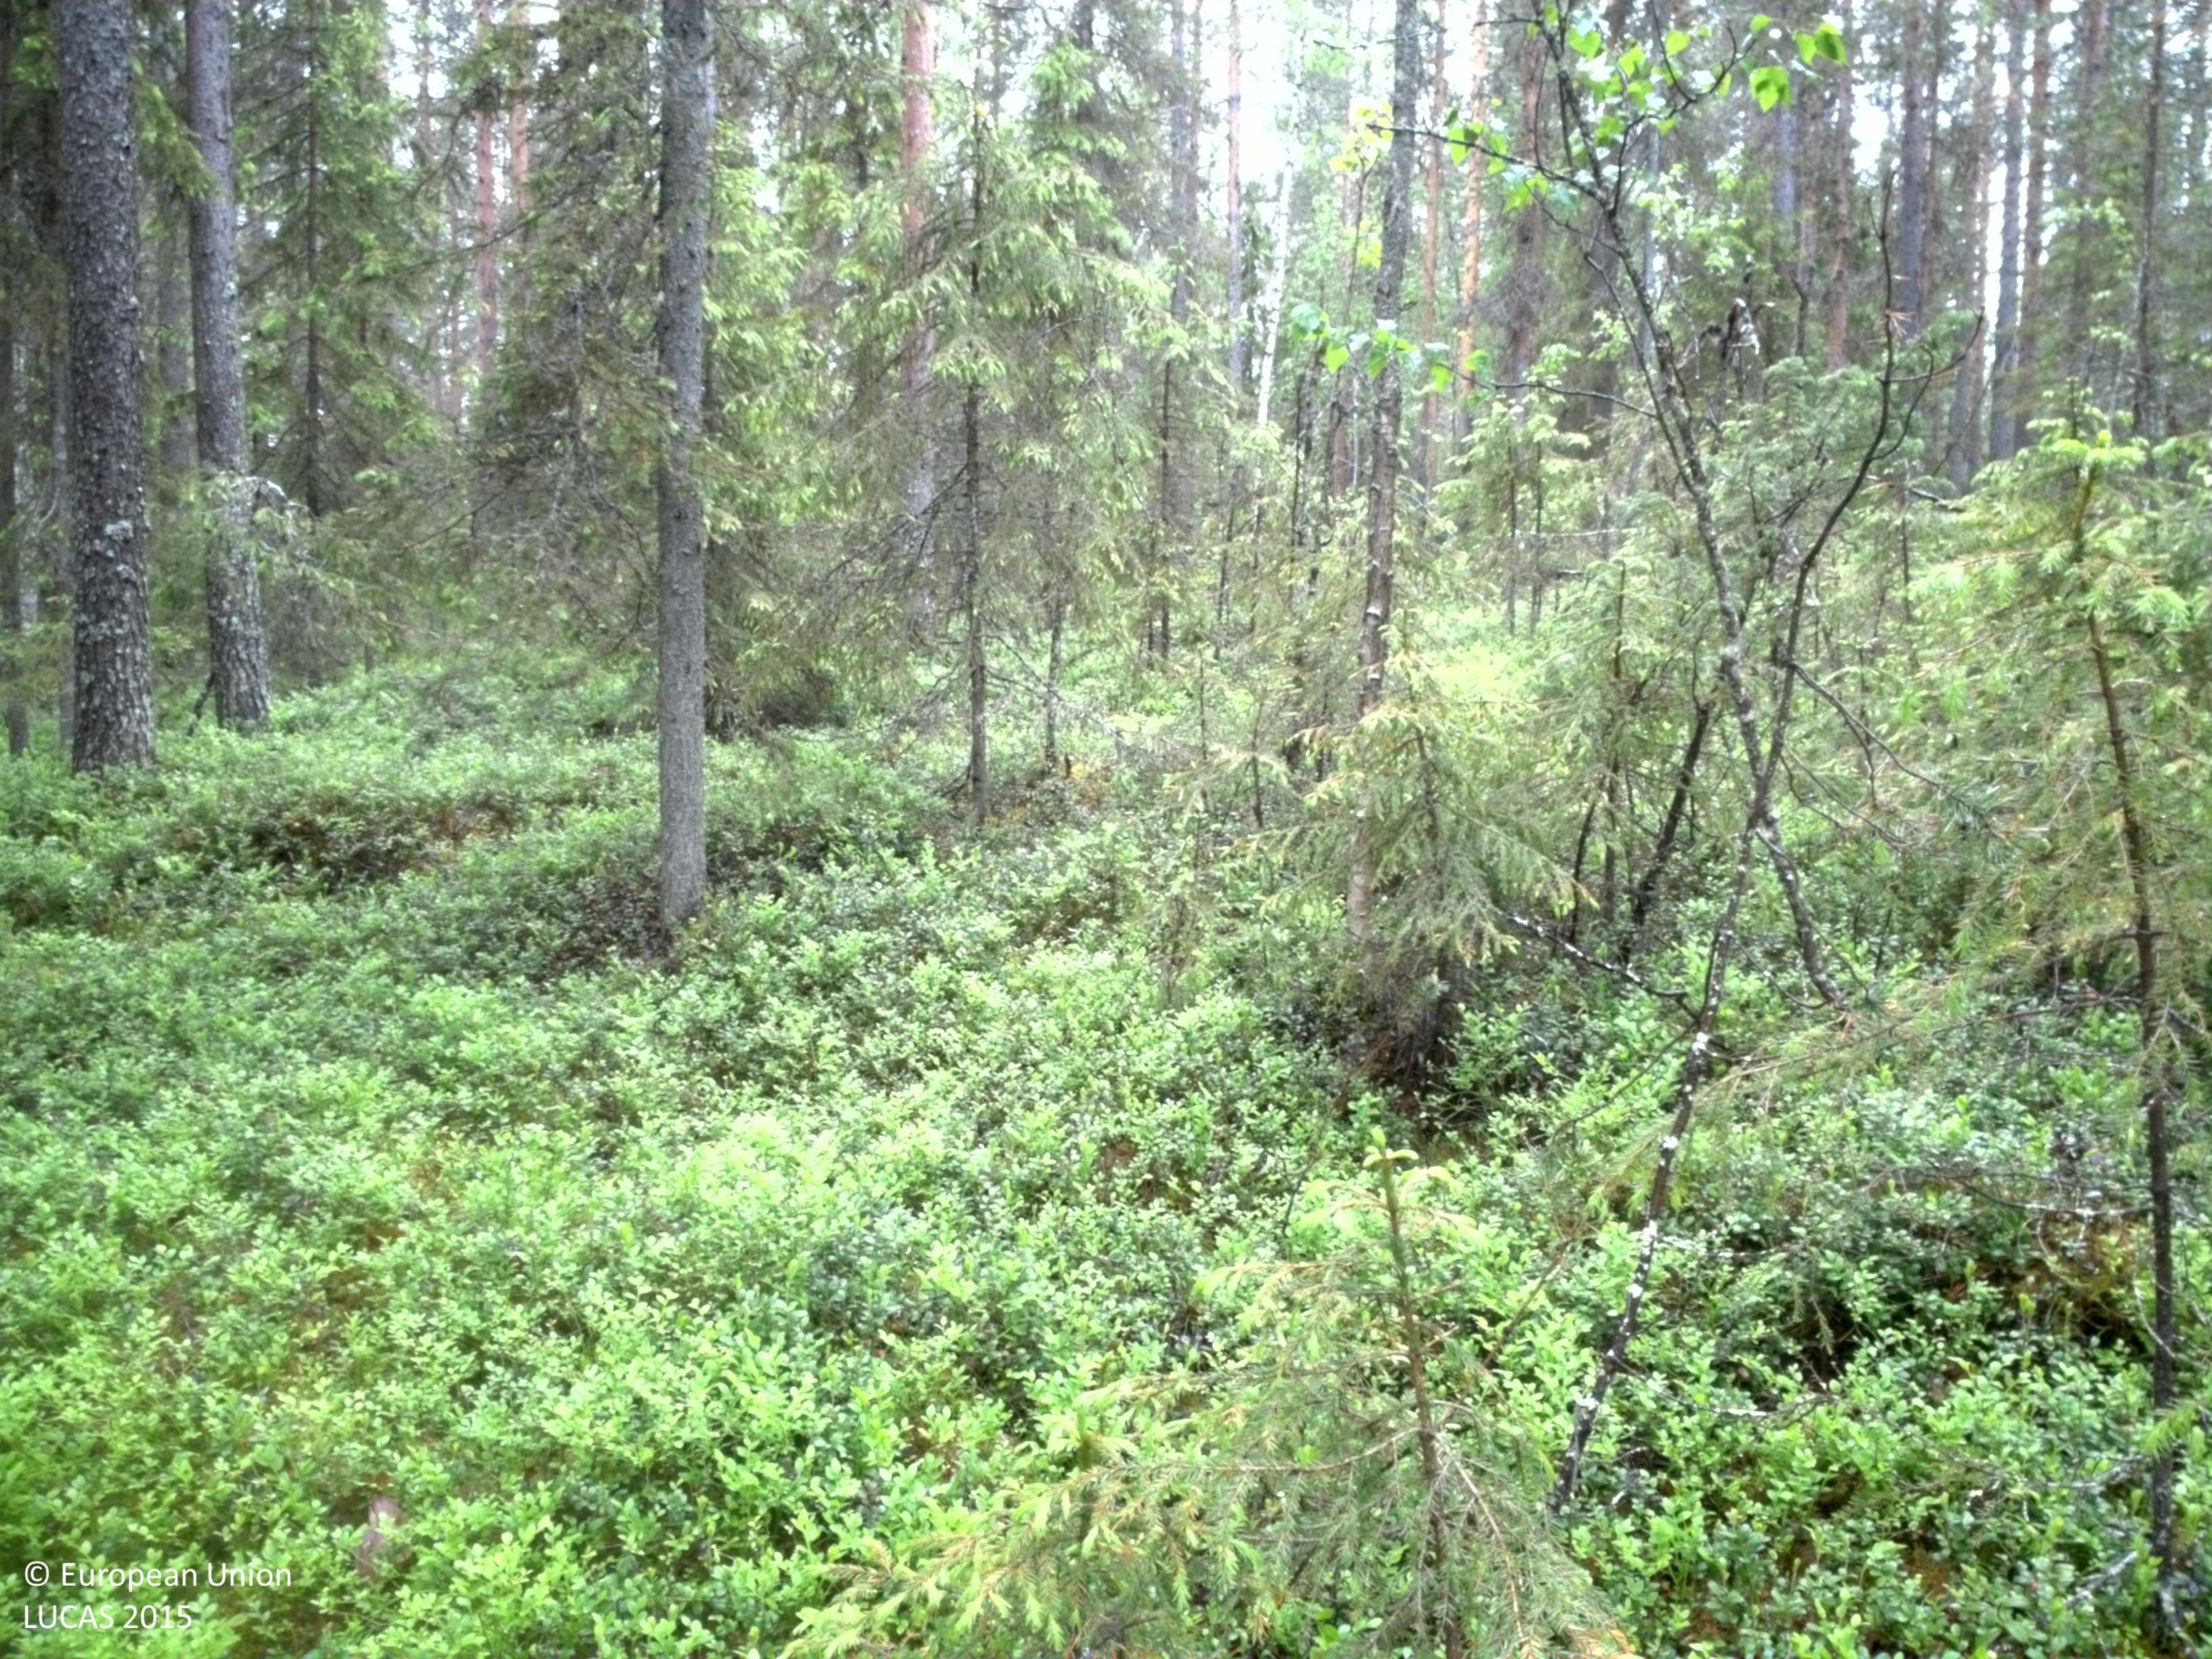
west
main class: Woodland
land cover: Pine dominated coniferous woodland
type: boreal forest
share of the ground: 50 - 75 %
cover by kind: coniferous forest trees 45 %, shrubs 45 %, broadleaved forest trees 10 %
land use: Forestry
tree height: > 5 m
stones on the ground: 10 - 25 %
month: June
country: SE
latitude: 66.4713
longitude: 22.7479
